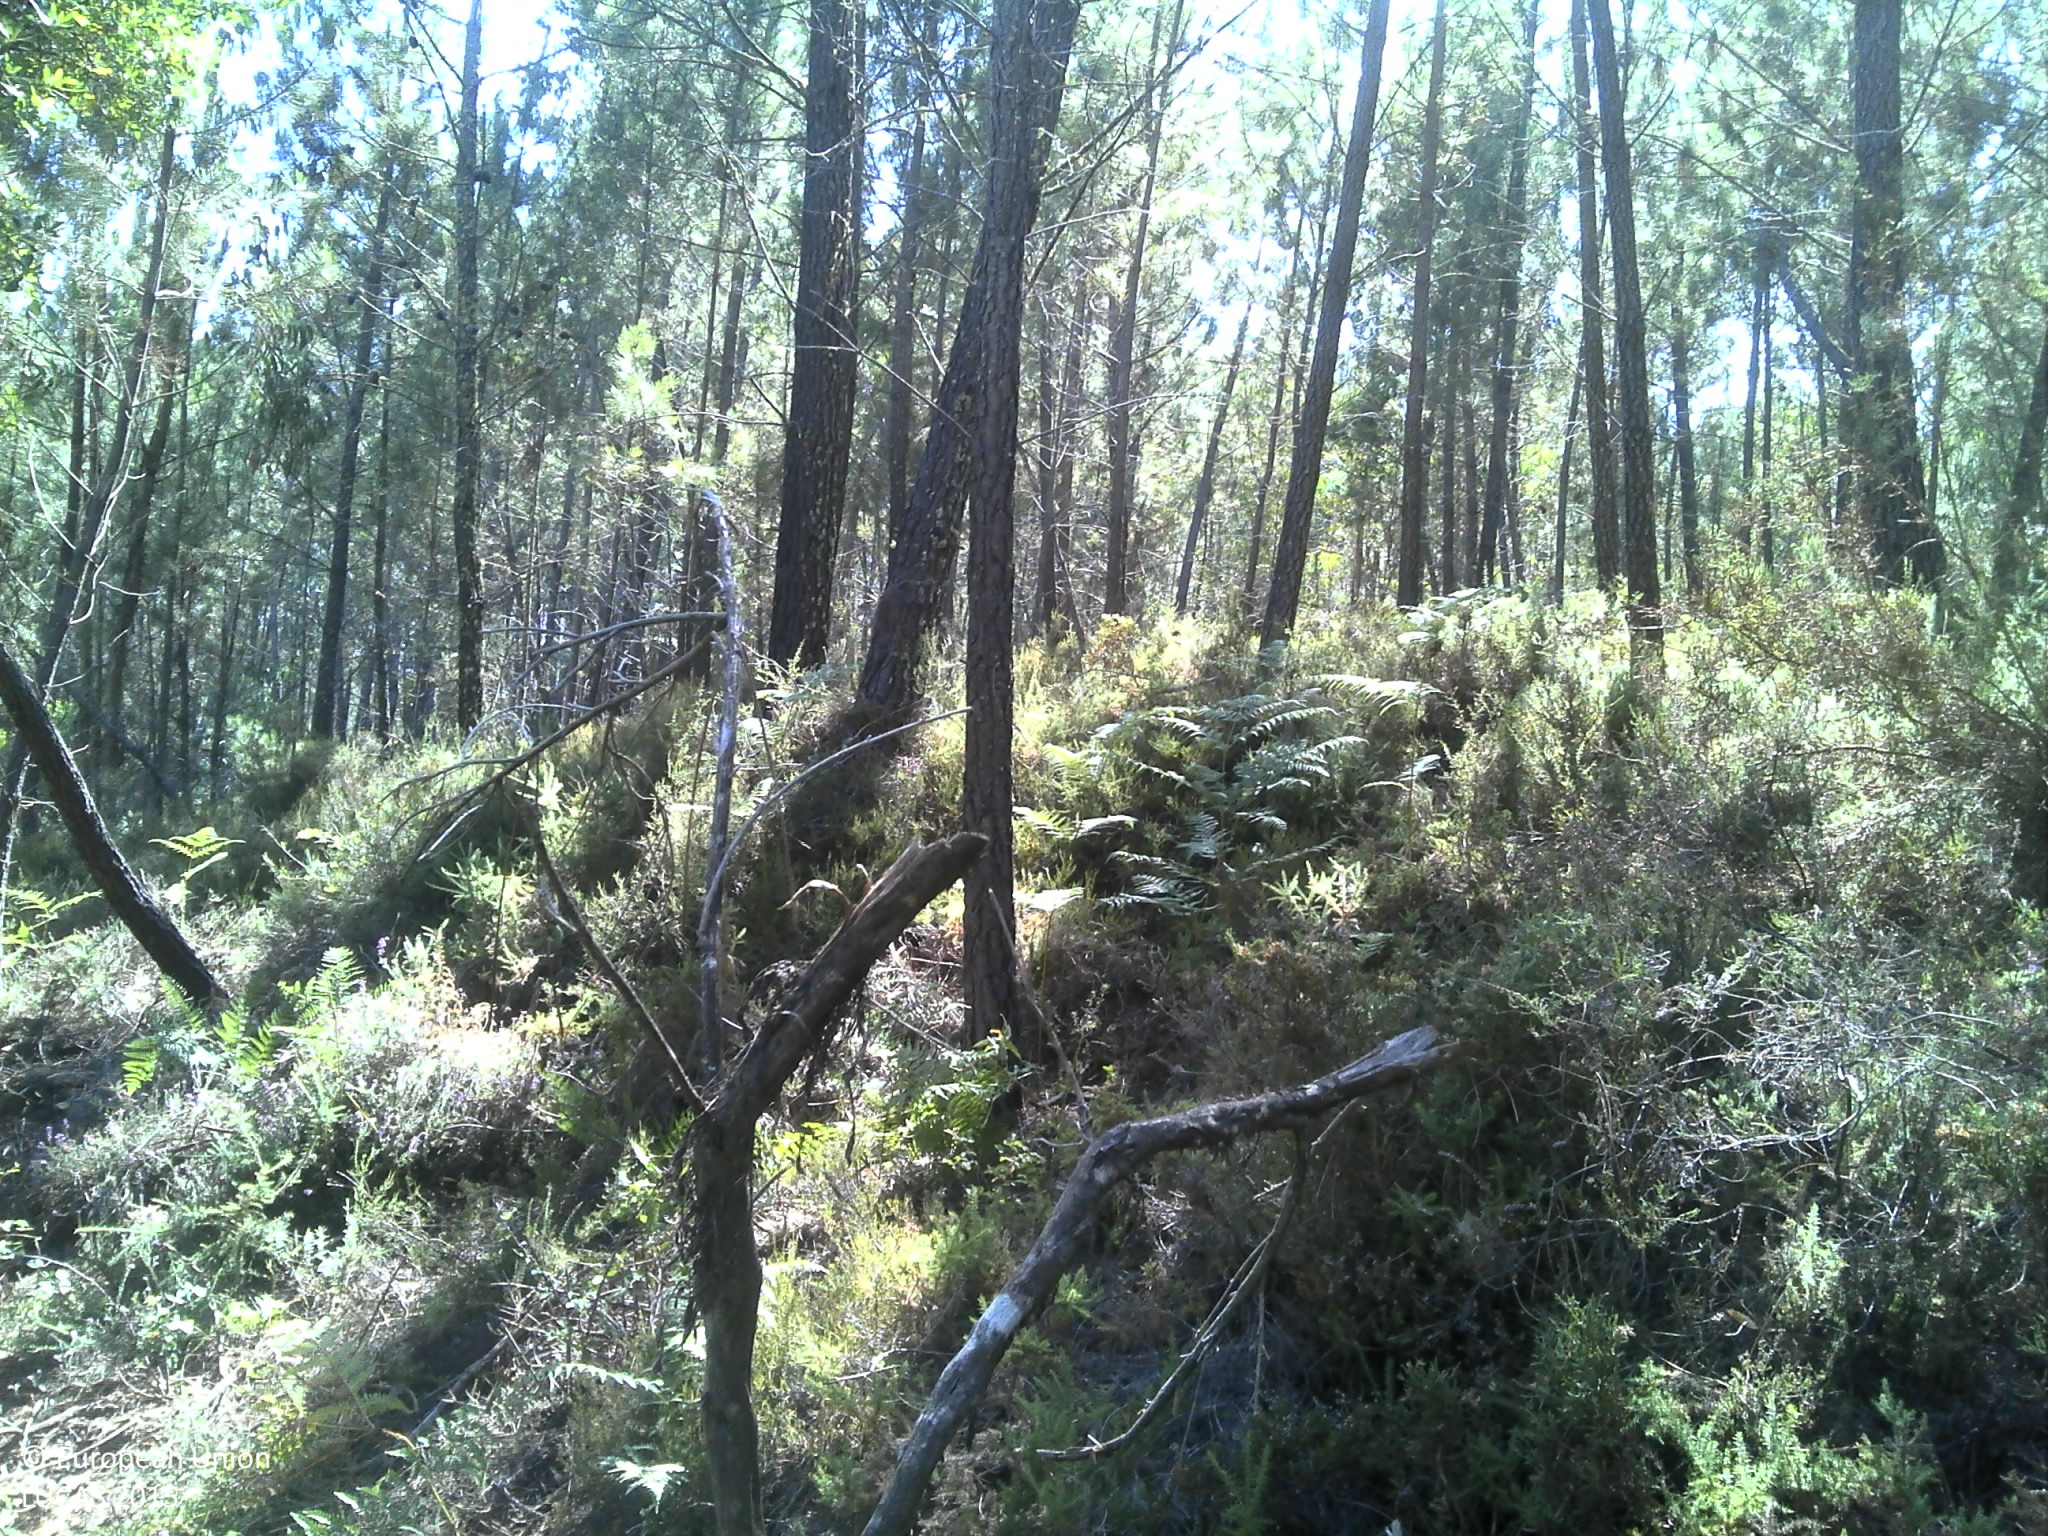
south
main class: Woodland
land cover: Pine dominated coniferous woodland
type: coniferous forest of the mediterranean region
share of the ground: 25 - 50 %
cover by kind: coniferous forest trees 50 %, shrubs 35 %, unconsolidated bare surface 15 %
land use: Forestry
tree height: > 5 m
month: July
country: PT
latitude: 39.9645
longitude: -7.8469
